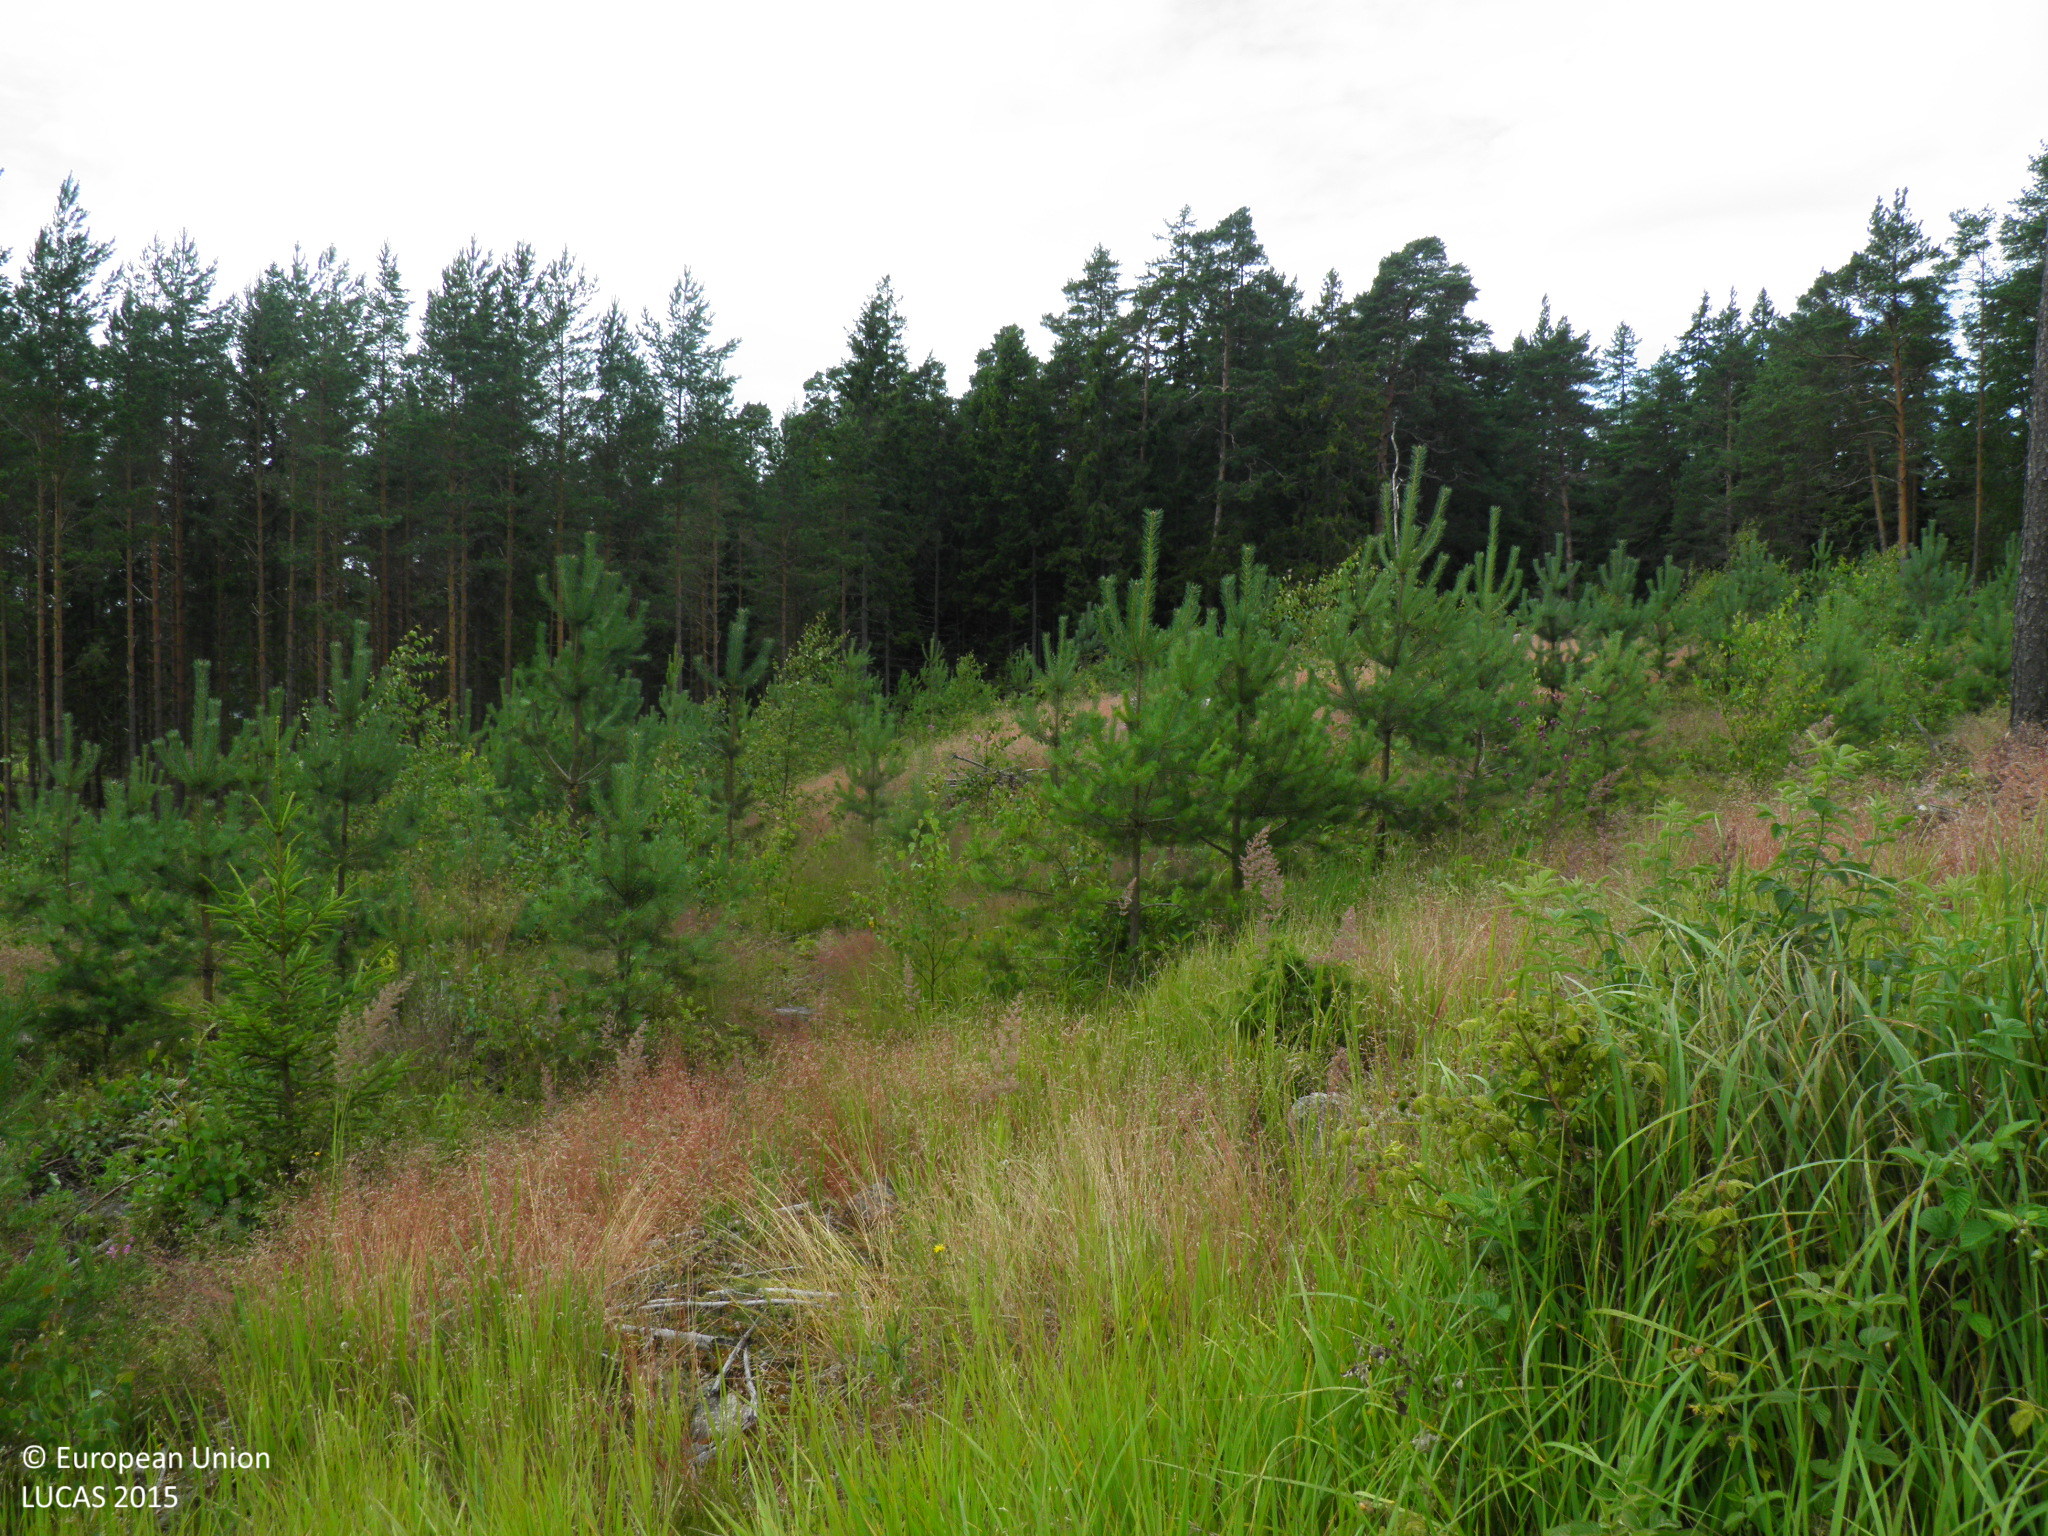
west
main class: Grassland
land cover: Grassland with sparse tree/shrub cover
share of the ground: > 75 %
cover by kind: herbaceous plants 70 %, shrubs 10 %, coniferous forest trees 5 %, consolidated bare surface 5 %, unconsolidated bare surface 5 %
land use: Forestry
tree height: < 5 m
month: July
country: FI
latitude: 60.2221
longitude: 22.7295
